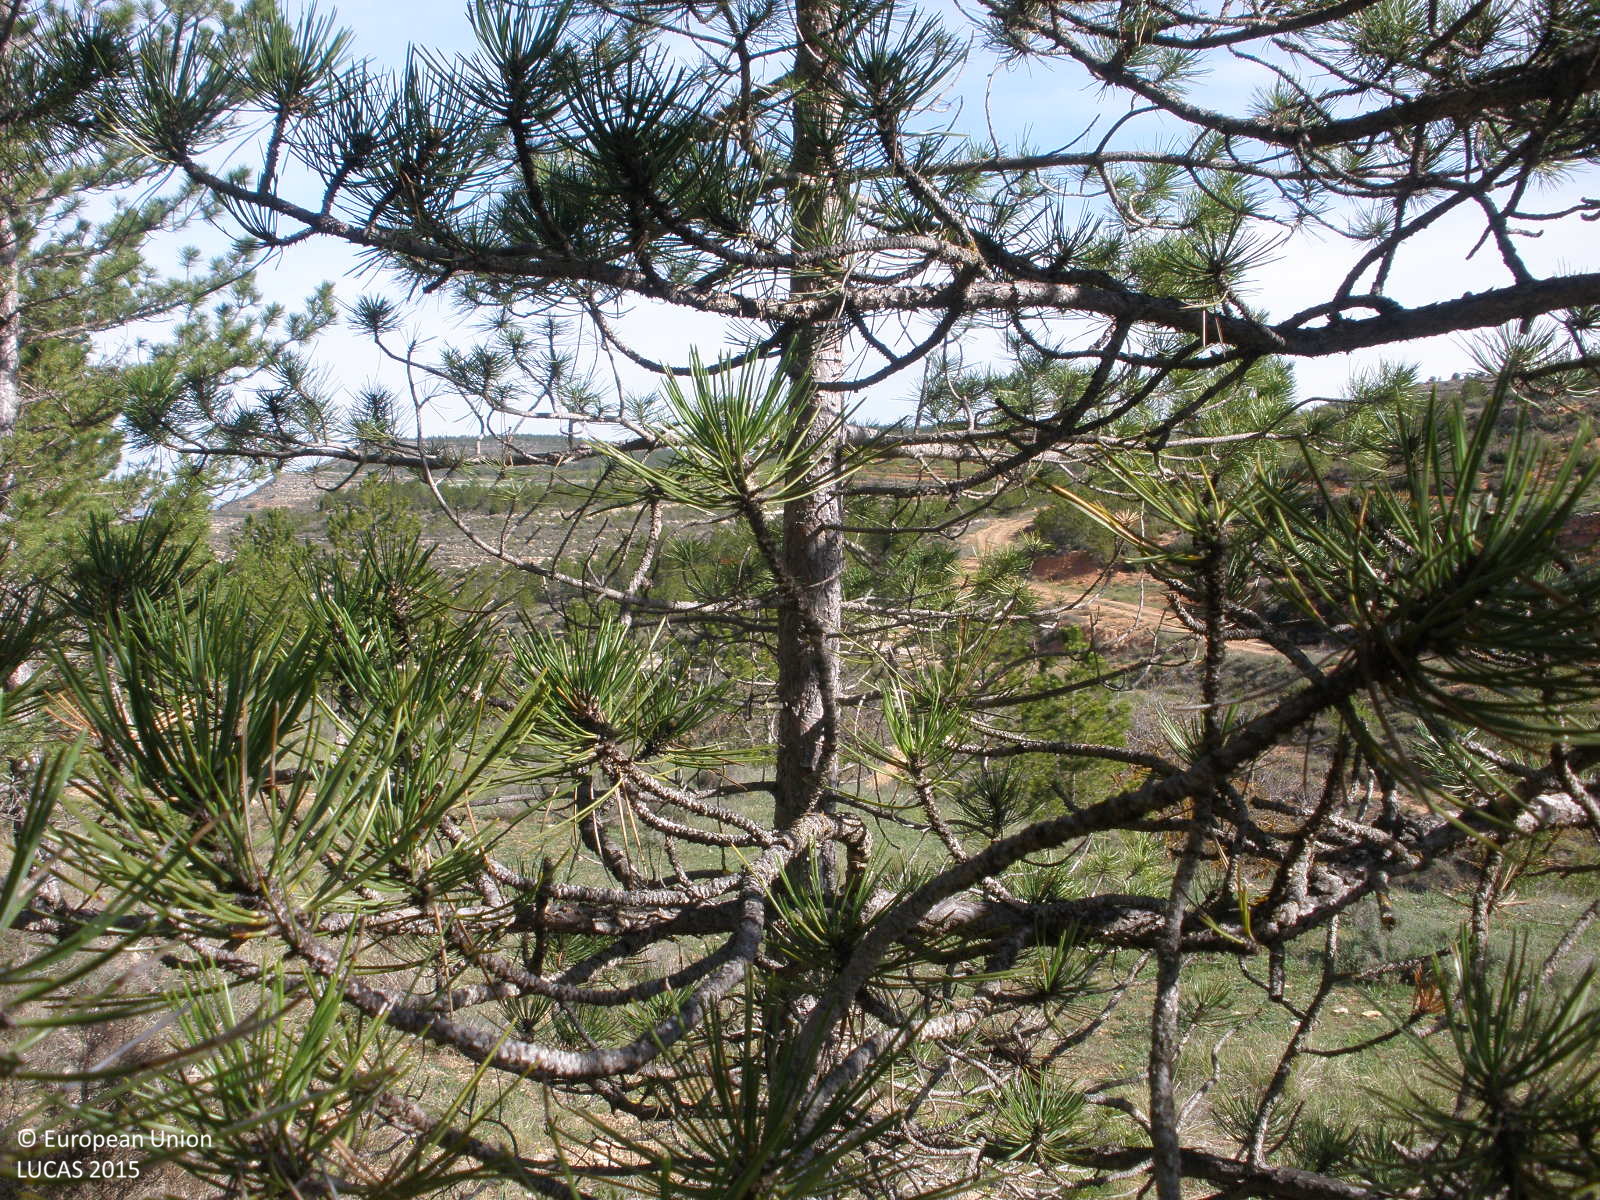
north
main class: Woodland
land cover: Pine dominated coniferous woodland
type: coniferous forest of the mediterranean region
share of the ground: 25 - 50 %
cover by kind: coniferous forest trees 40 %, shrubs 40 %, herbaceous plants 20 %
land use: Semi-natural and natural areas not in use
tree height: > 5 m
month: April
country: ES
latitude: 40.0819
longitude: -1.1845
